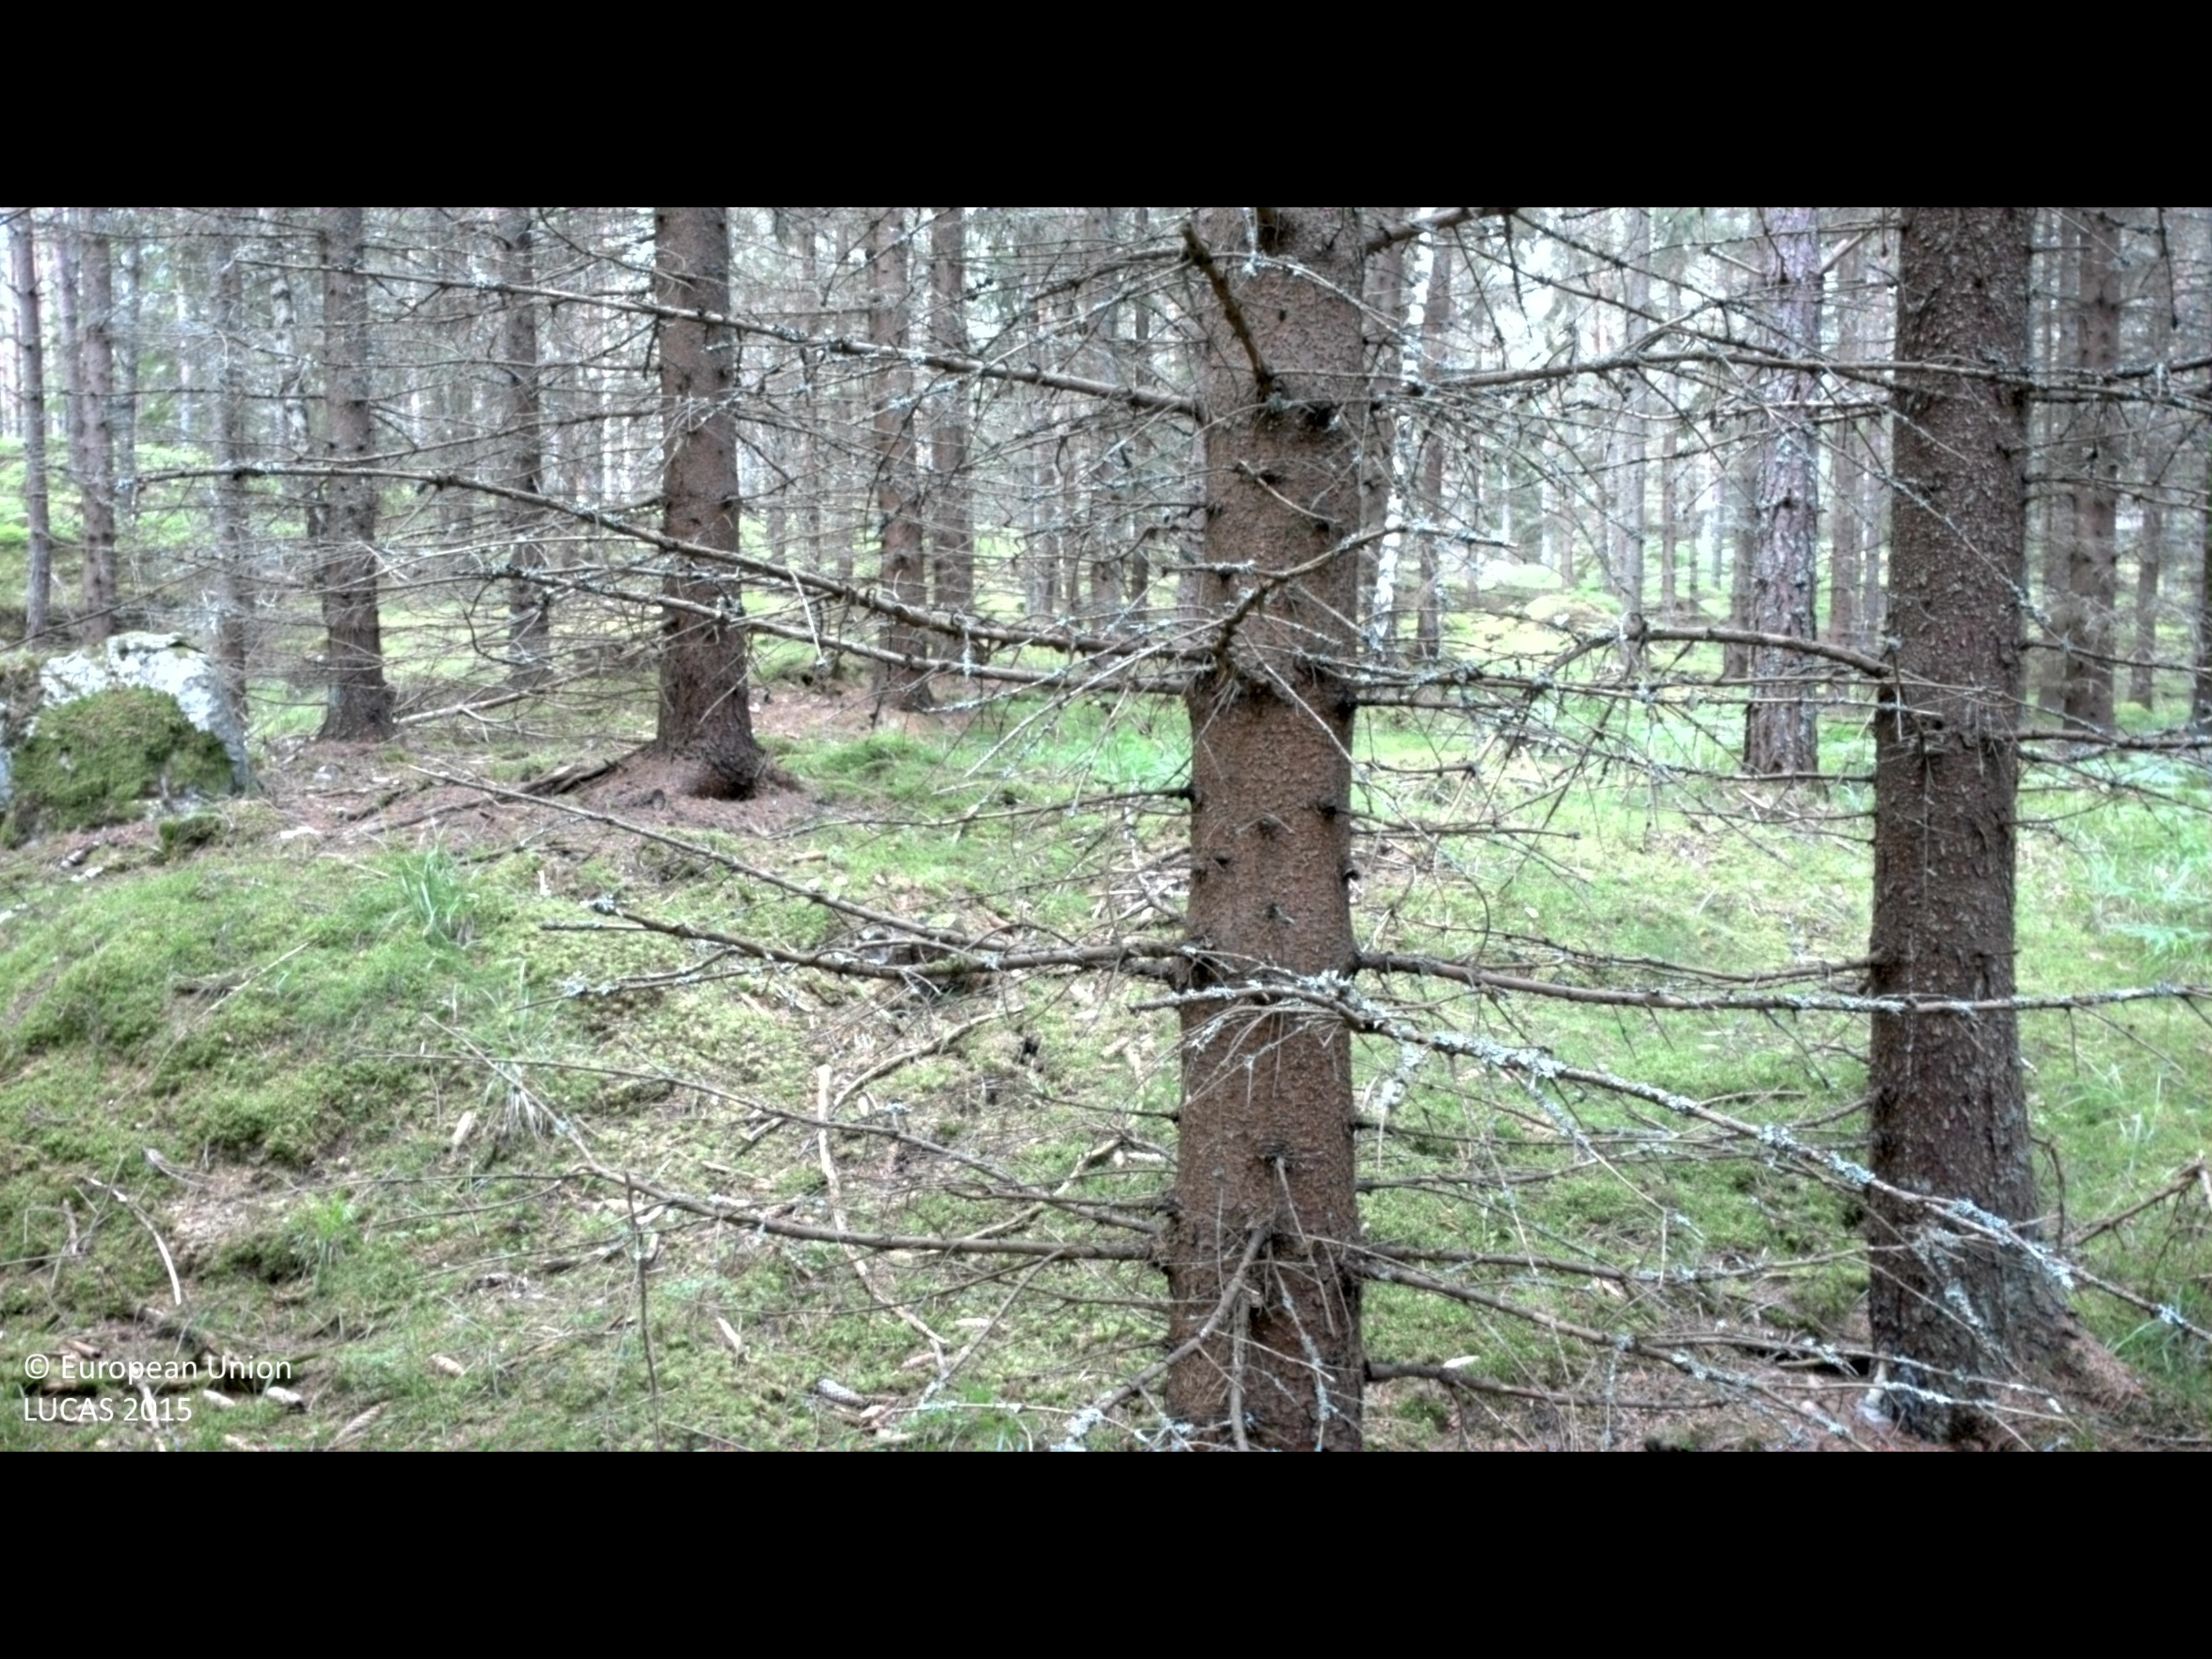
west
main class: Woodland
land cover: Spruce dominated coniferous woodland
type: boreal forest
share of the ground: > 75 %
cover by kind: coniferous forest trees 70 %, broadleaved forest trees 15 %, lichens and mosses 10 %, shrubs 5 %
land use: Forestry
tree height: > 5 m
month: June
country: SE
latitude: 58.2430
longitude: 16.1115
